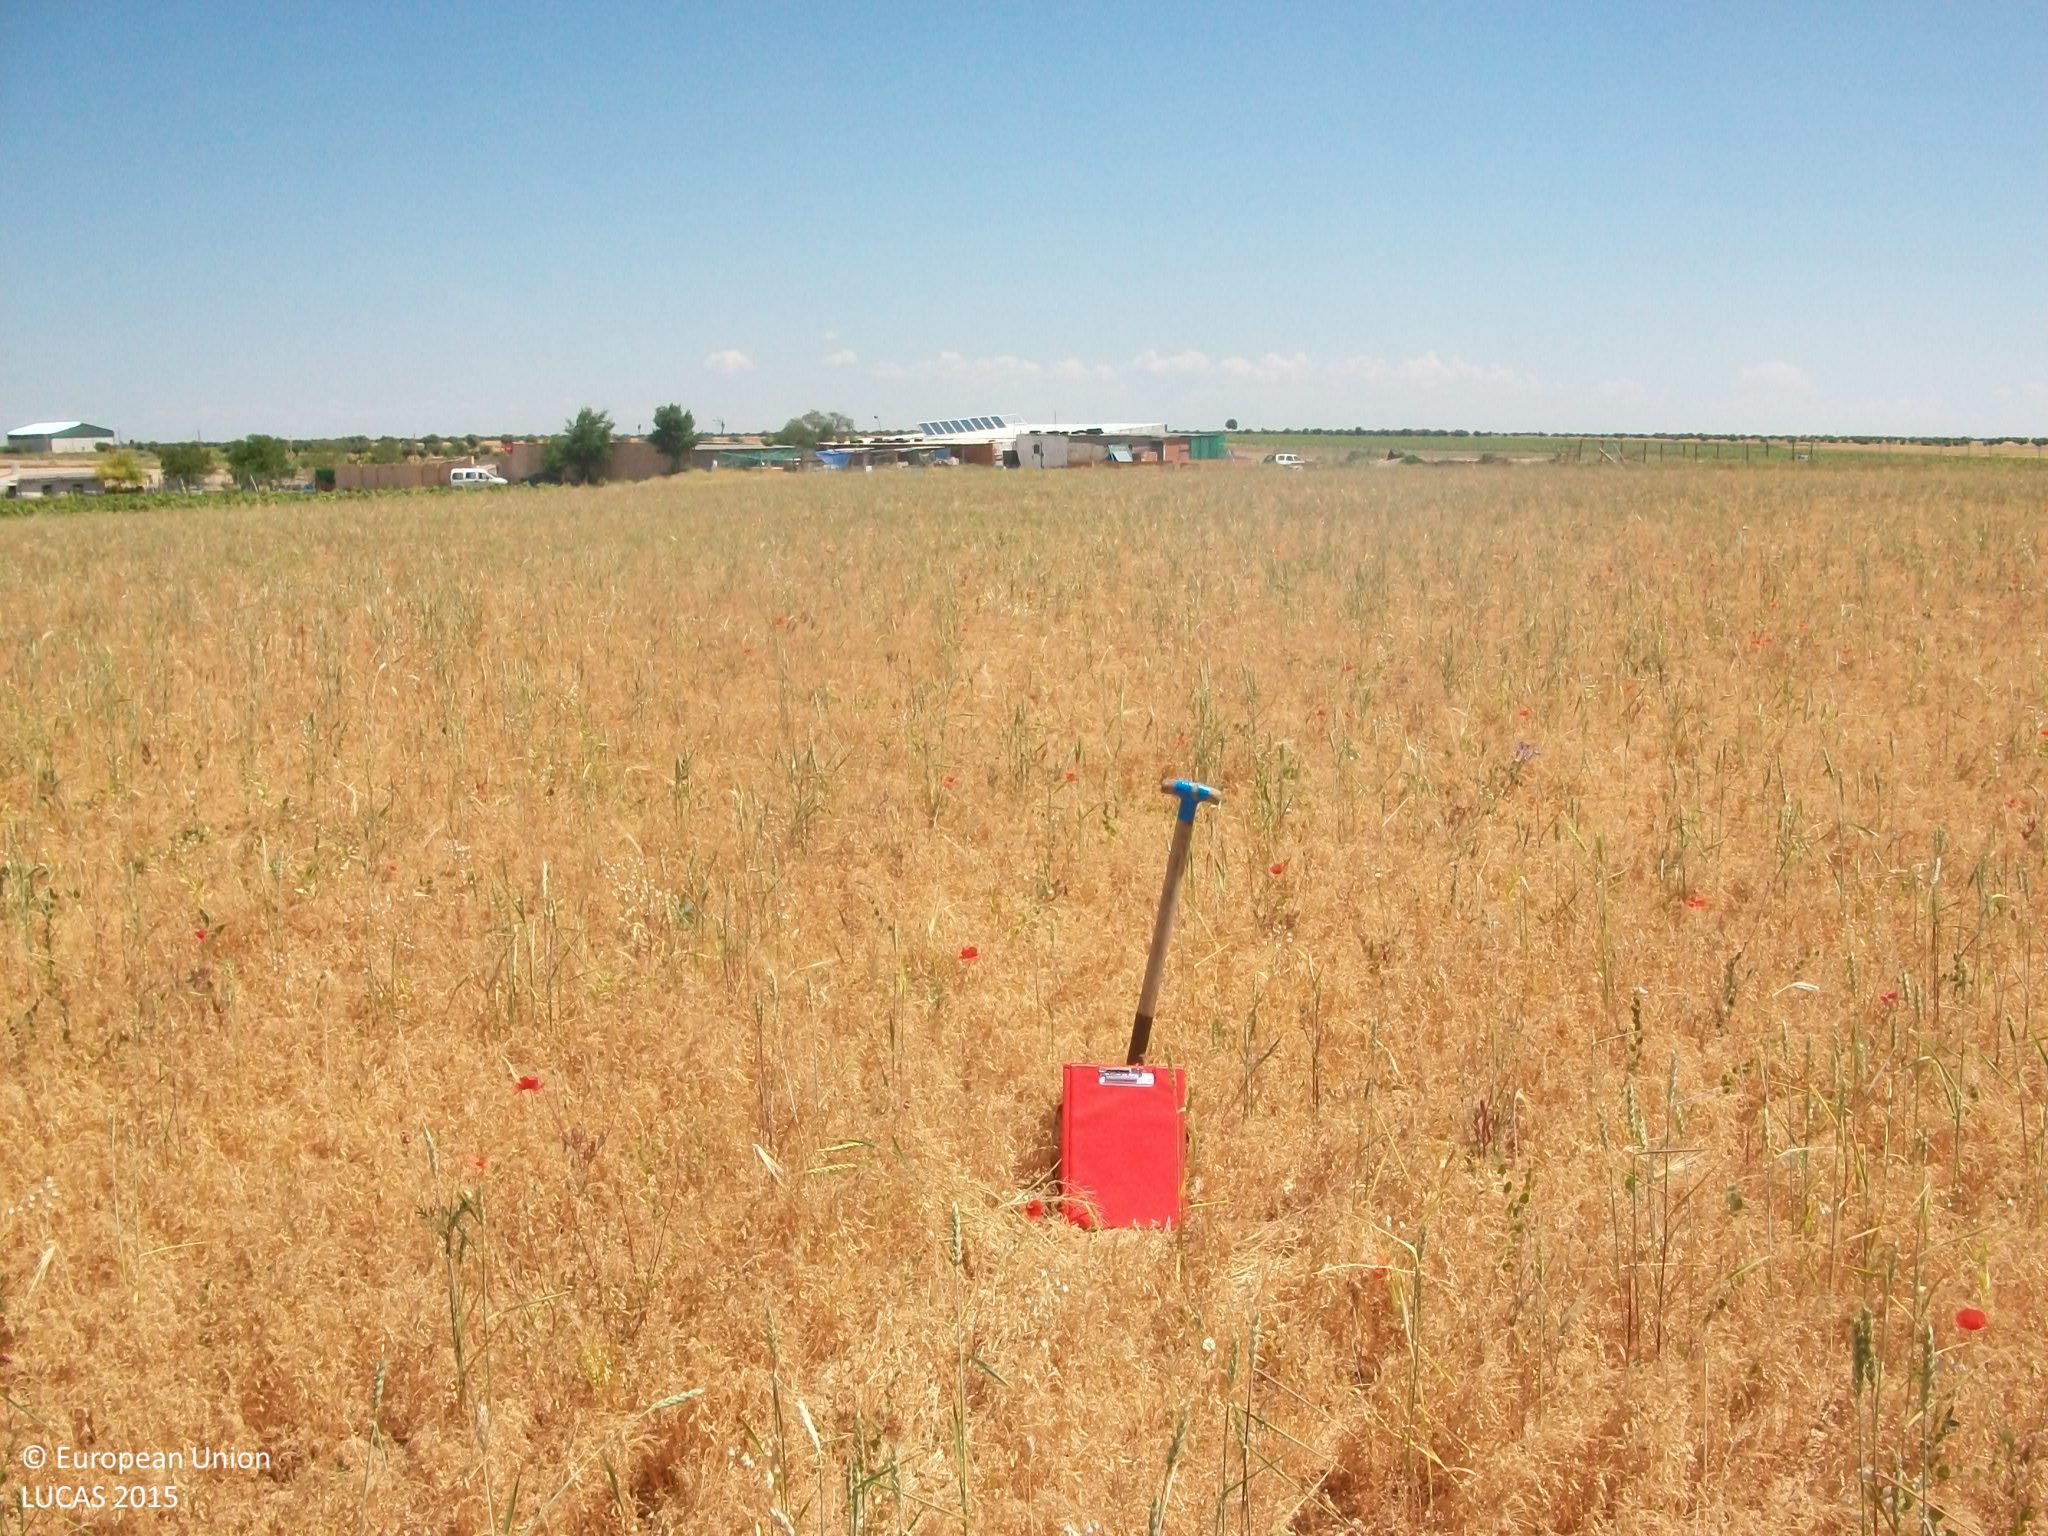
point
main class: Cropland
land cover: Common wheat
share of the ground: > 75 %
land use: Agriculture (excluding fallow land and kitchen gardens)
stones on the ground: > 50 %
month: May
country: ES
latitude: 39.9004
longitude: -3.6089
